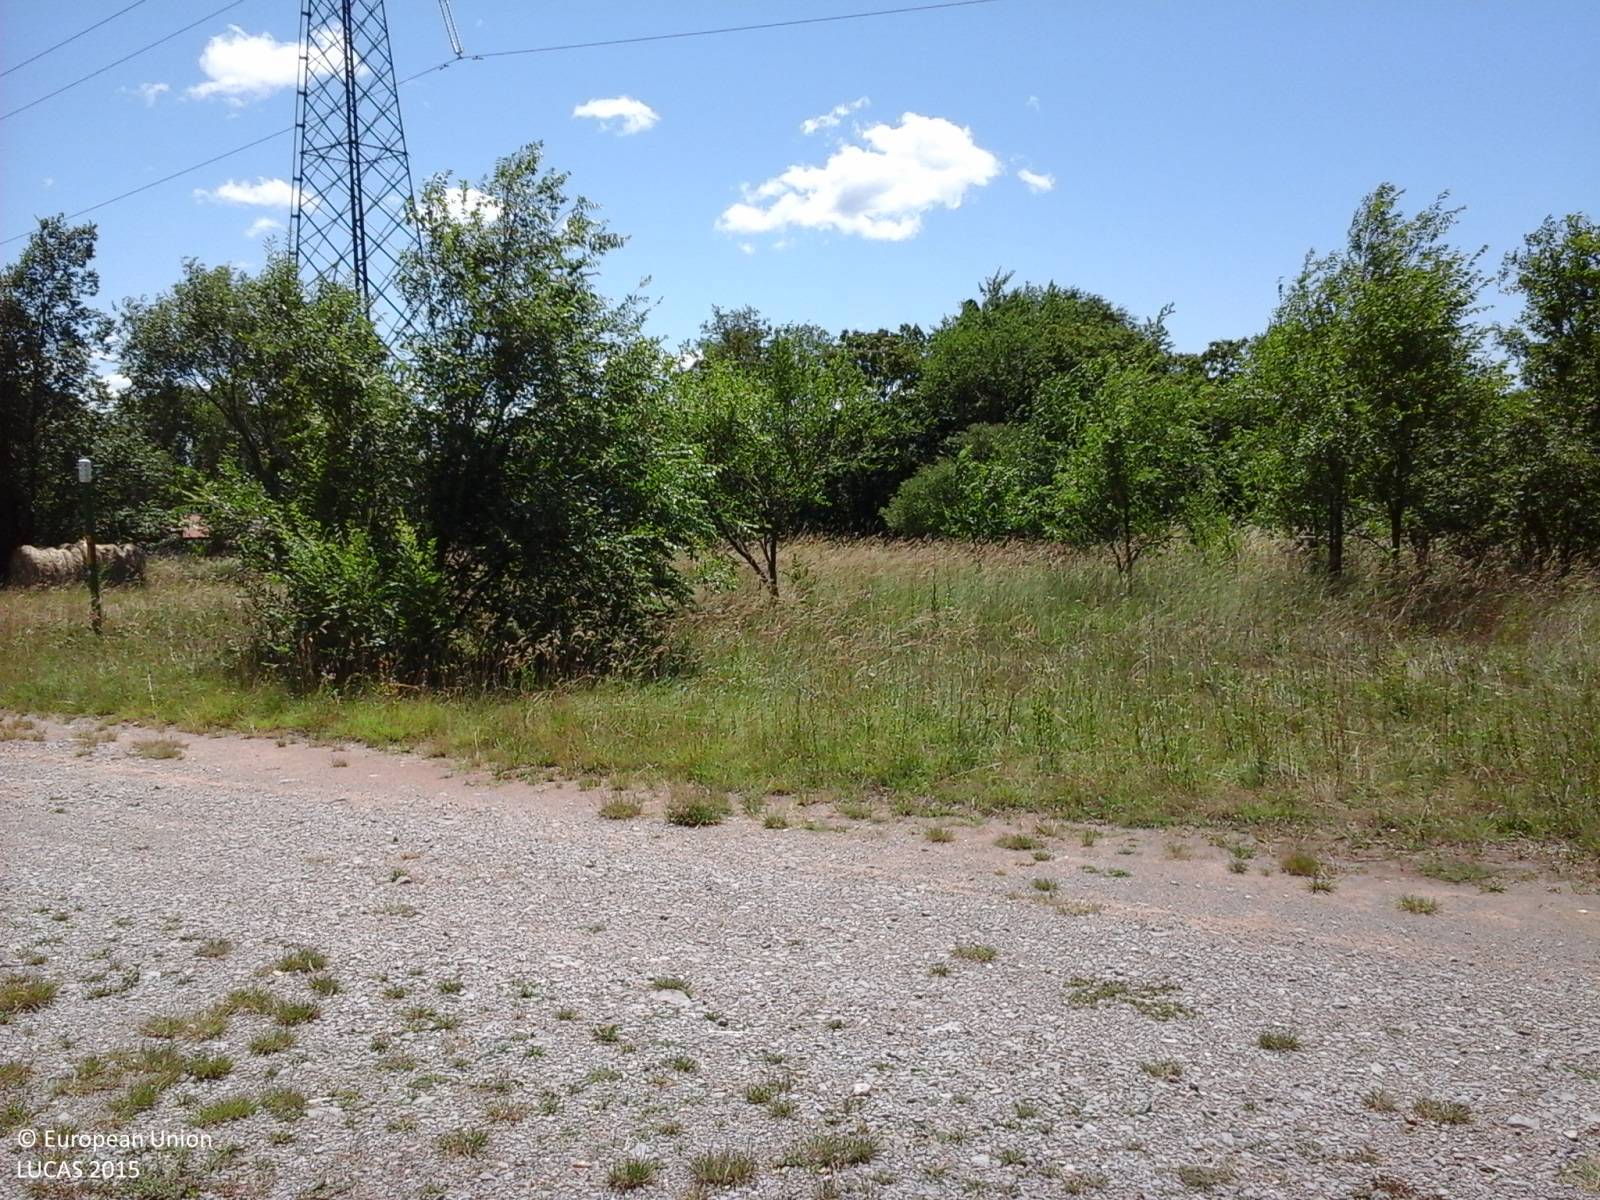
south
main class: Cropland
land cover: Other fresh vegetables
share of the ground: > 75 %
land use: Kitchen garden
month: June
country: IT
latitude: 45.7648
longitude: 13.6861
